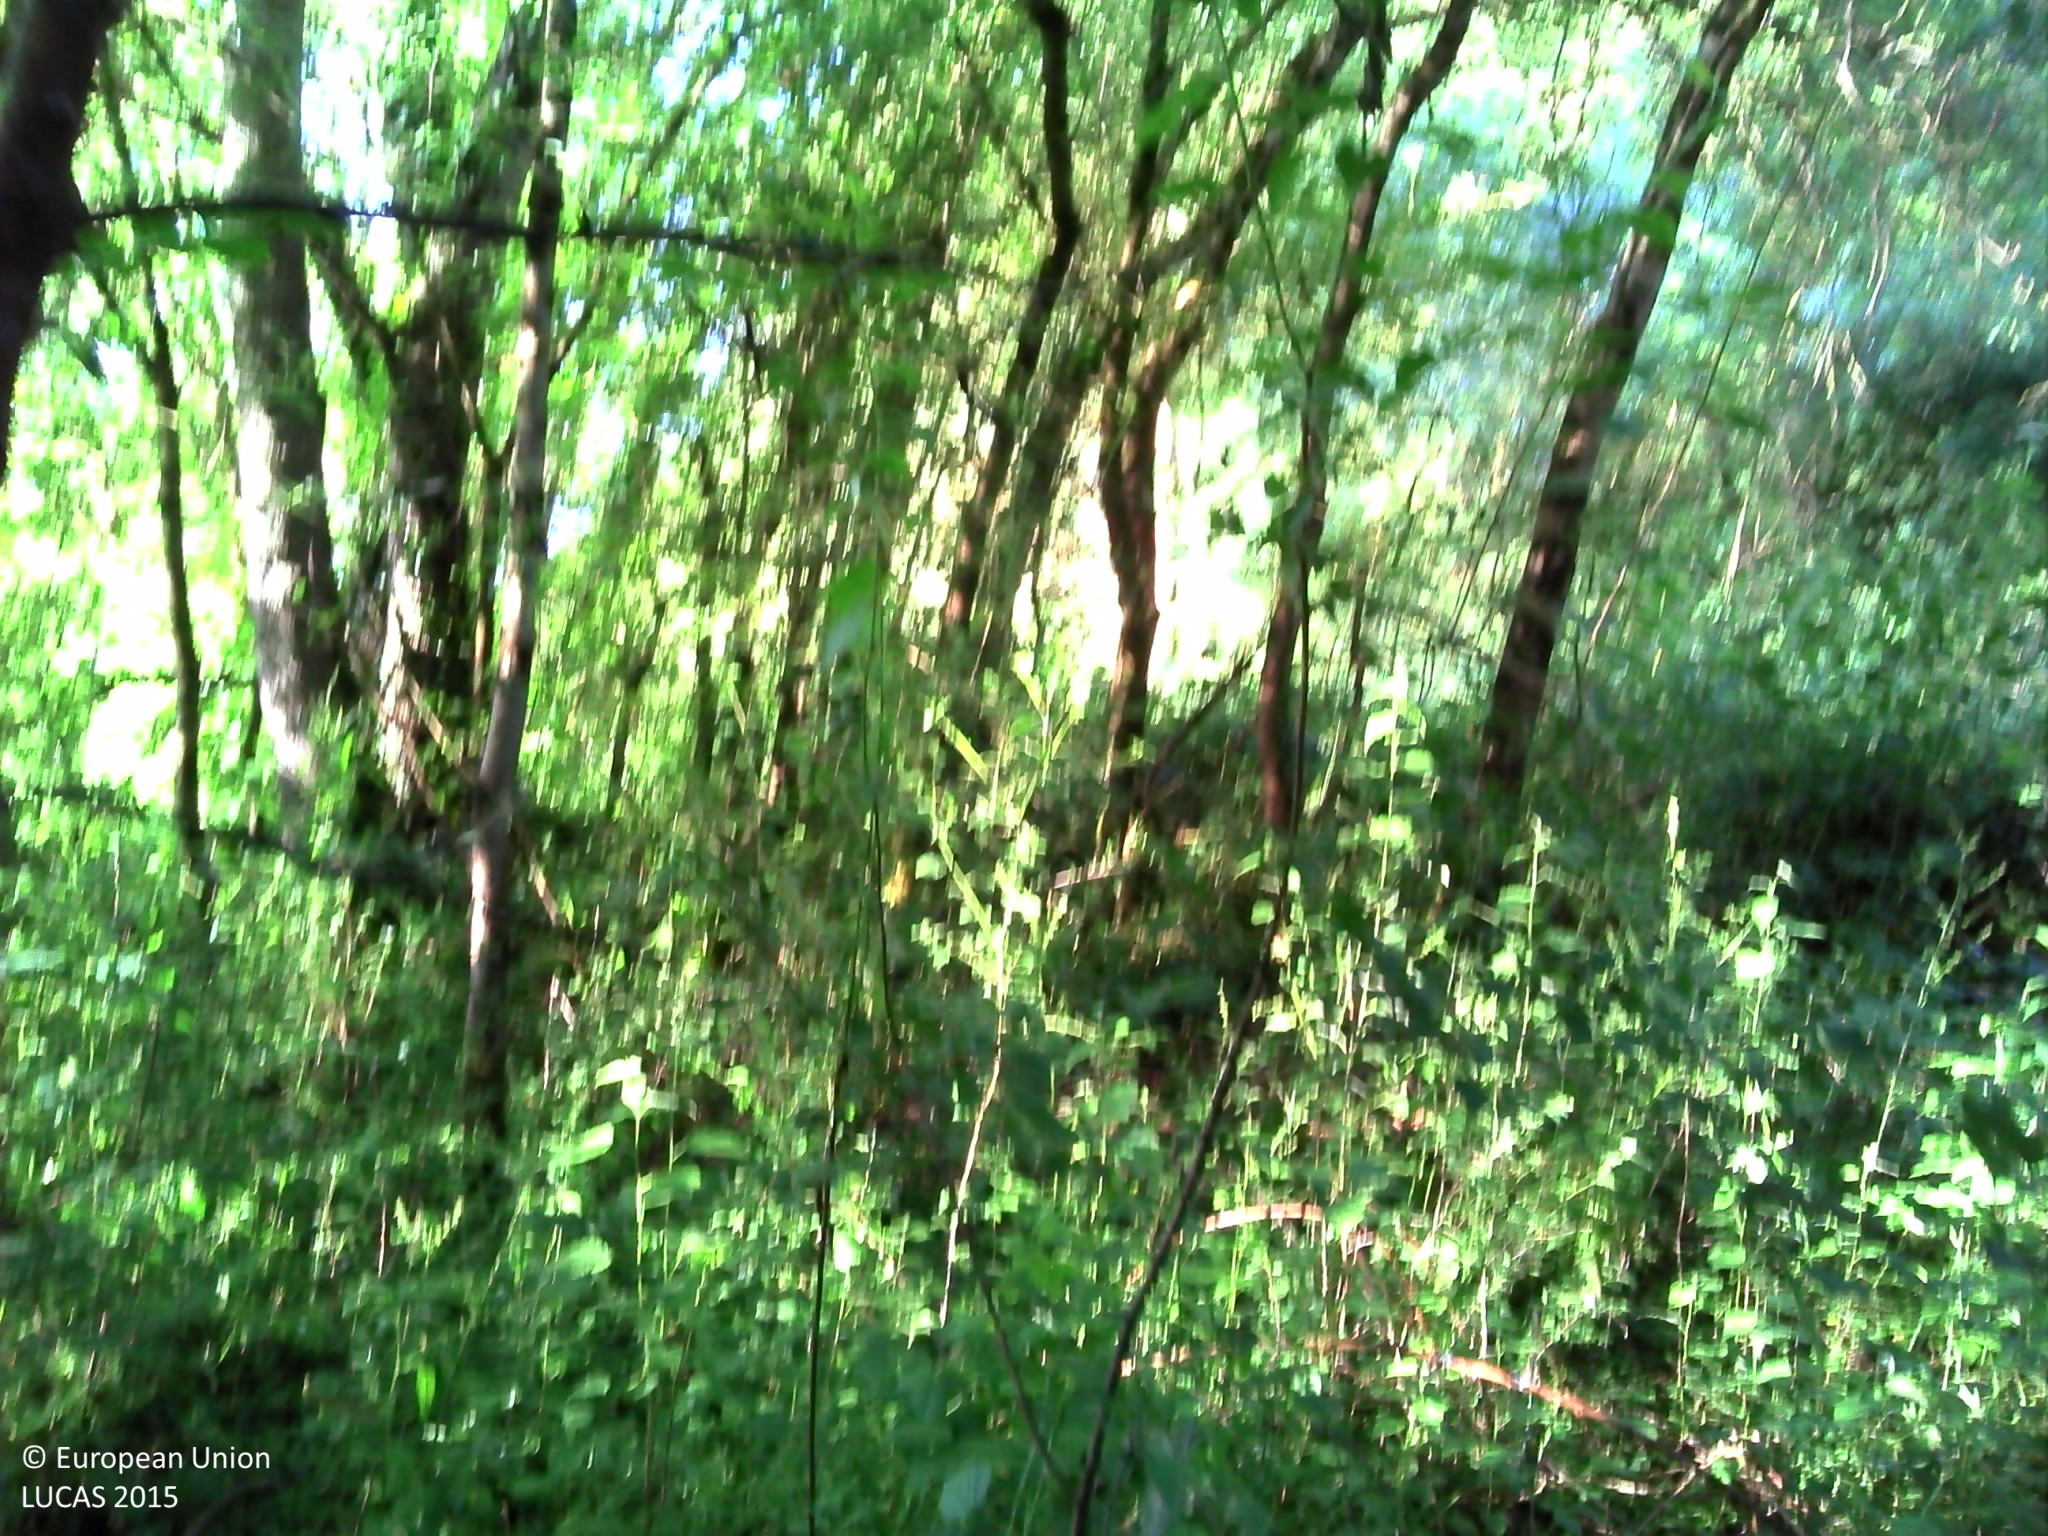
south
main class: Woodland
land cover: Broadleaved woodland
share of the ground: > 75 %
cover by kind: broadleaved forest trees 95 %, herbaceous plants 5 %
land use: Semi-natural and natural areas not in use
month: June
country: FR
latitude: 47.2234
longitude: -1.4644
